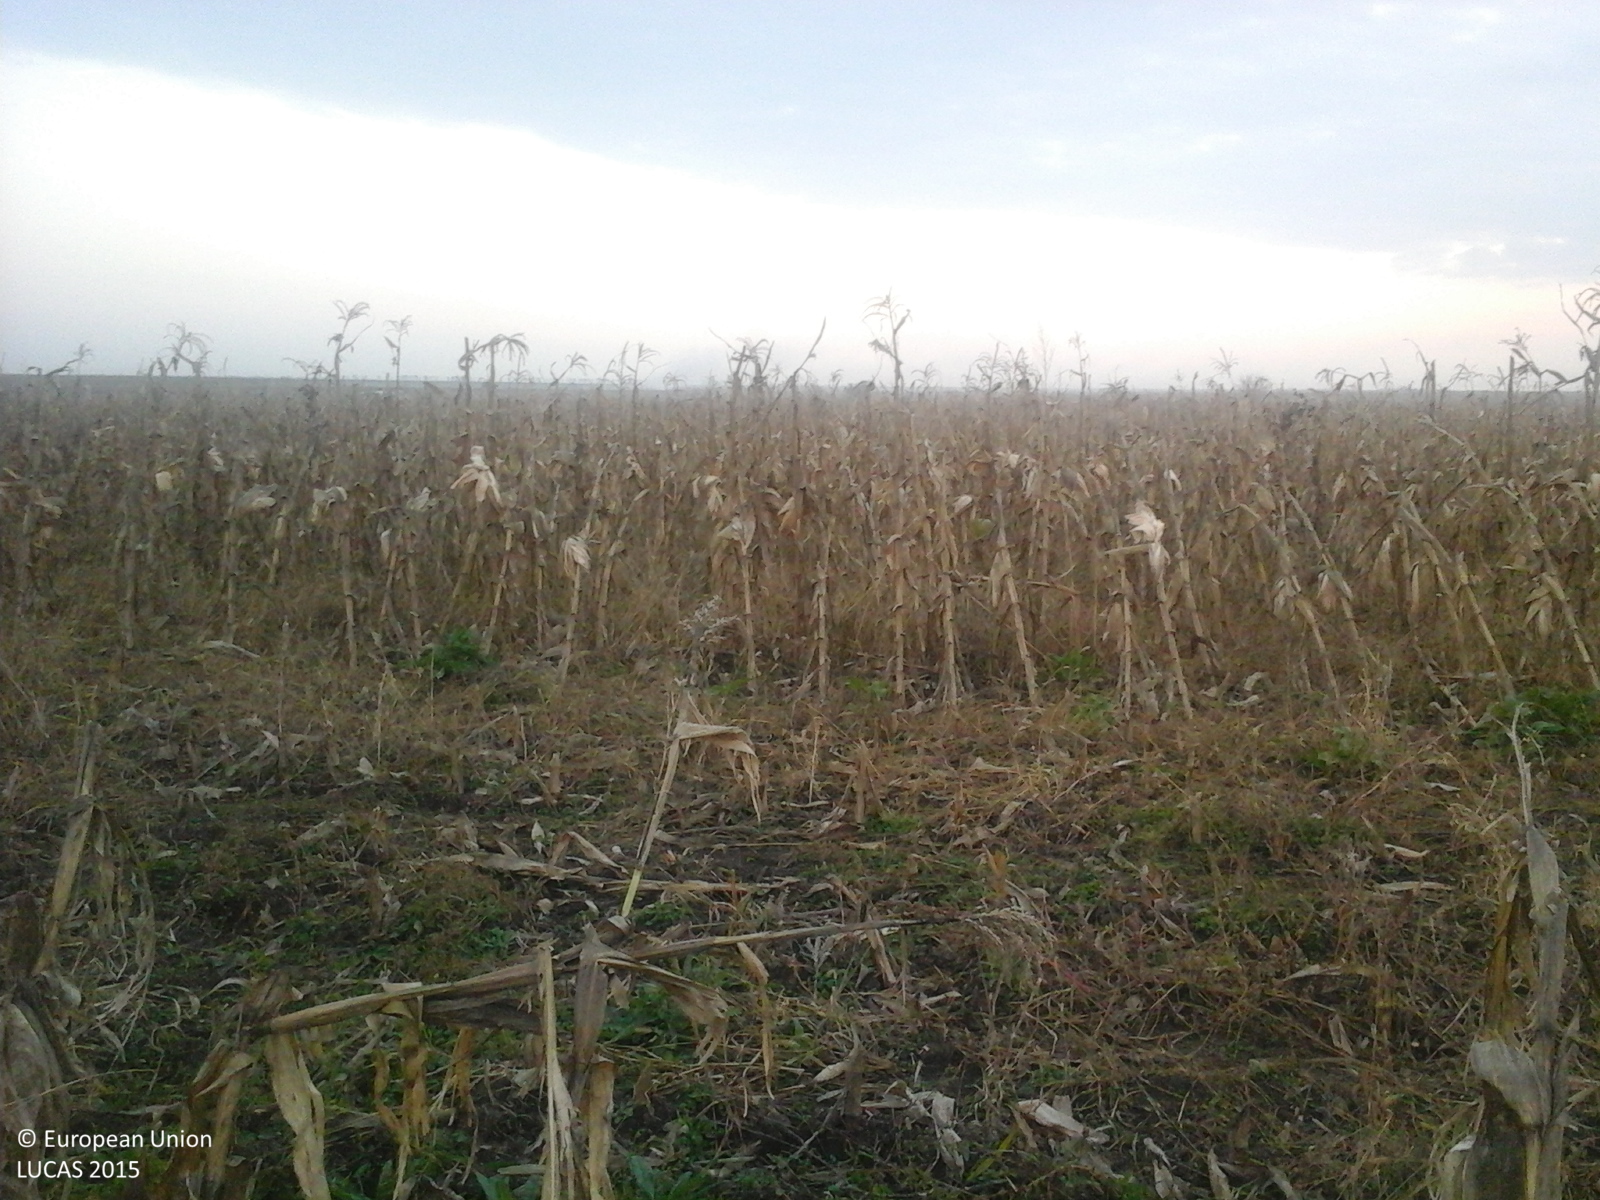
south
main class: Cropland
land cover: Maize
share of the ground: > 75 %
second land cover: Spontaneously vegetated surfaces
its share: 25 - 50 %
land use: Agriculture (excluding fallow land and kitchen gardens)
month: October
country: RO
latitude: 45.2677
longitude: 27.0251
